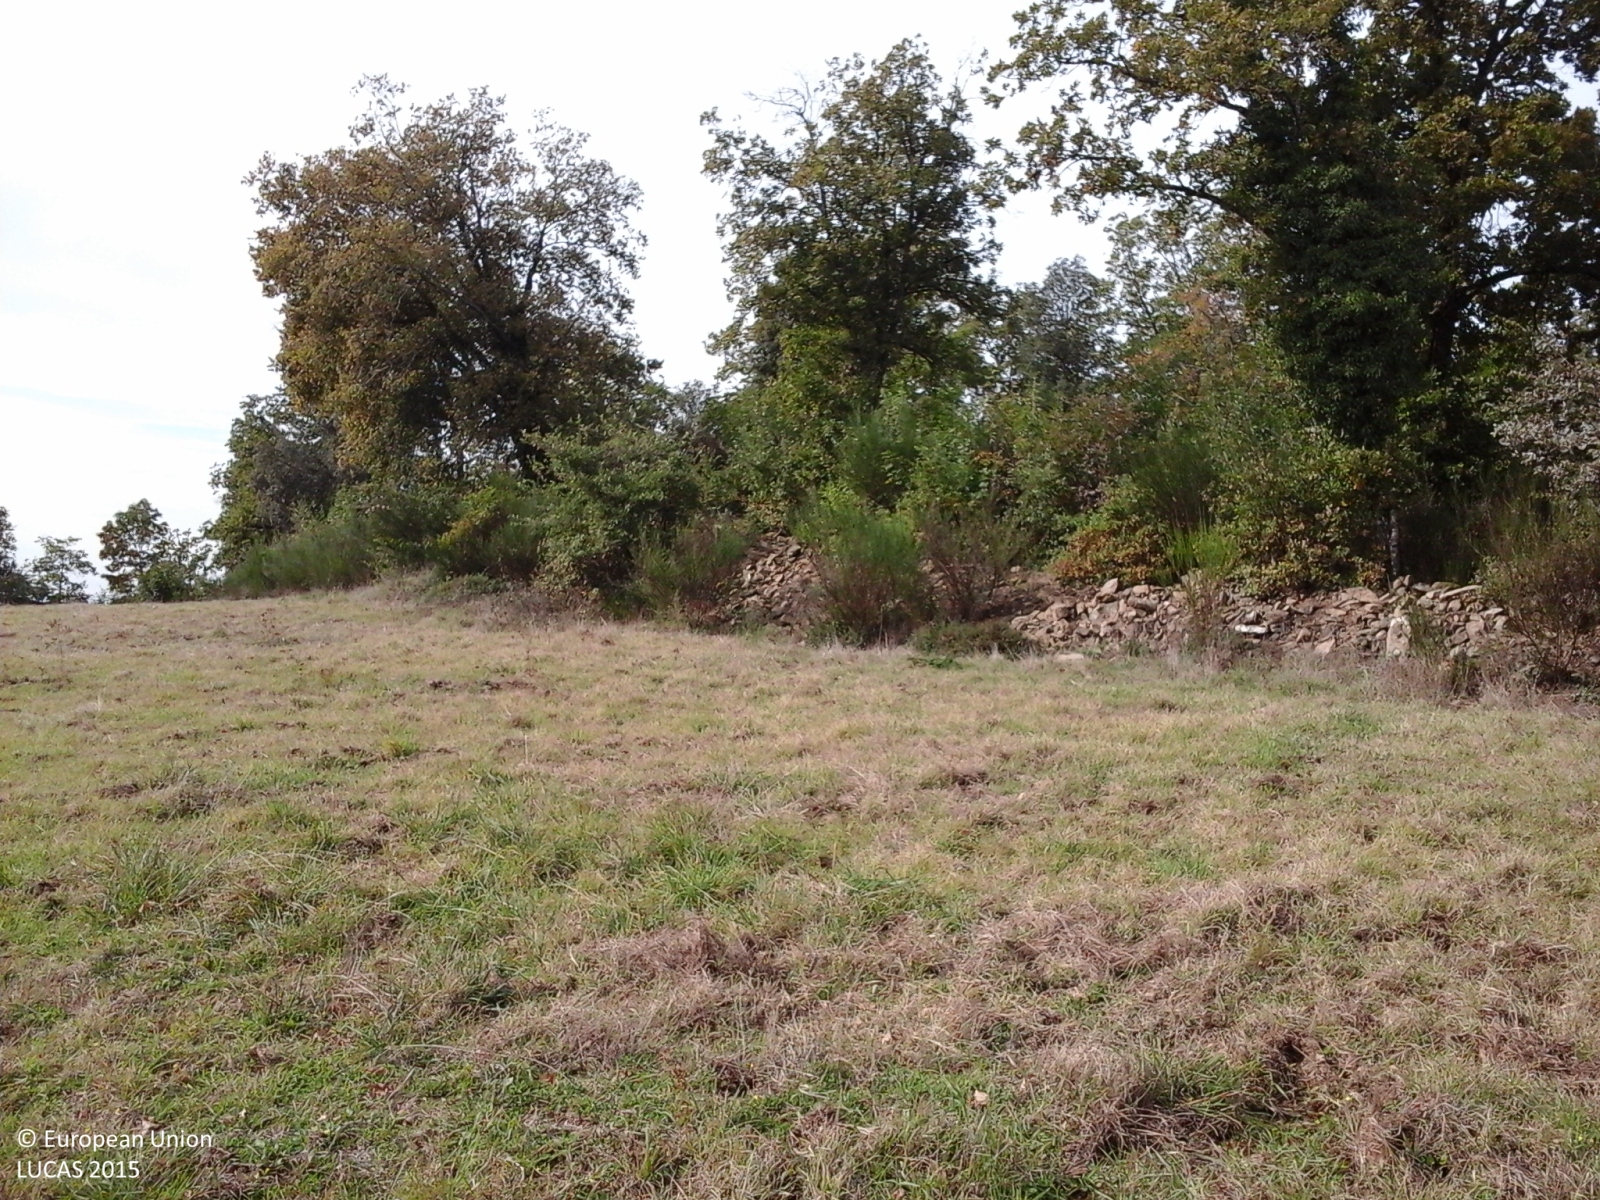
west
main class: Grassland
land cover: Grassland without tree/shrub cover
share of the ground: > 75 %
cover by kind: herbaceous plants 100 %
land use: Agriculture (excluding fallow land and kitchen gardens)
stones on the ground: < 10 %
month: October
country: IT
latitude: 43.4184
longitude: 11.5642
